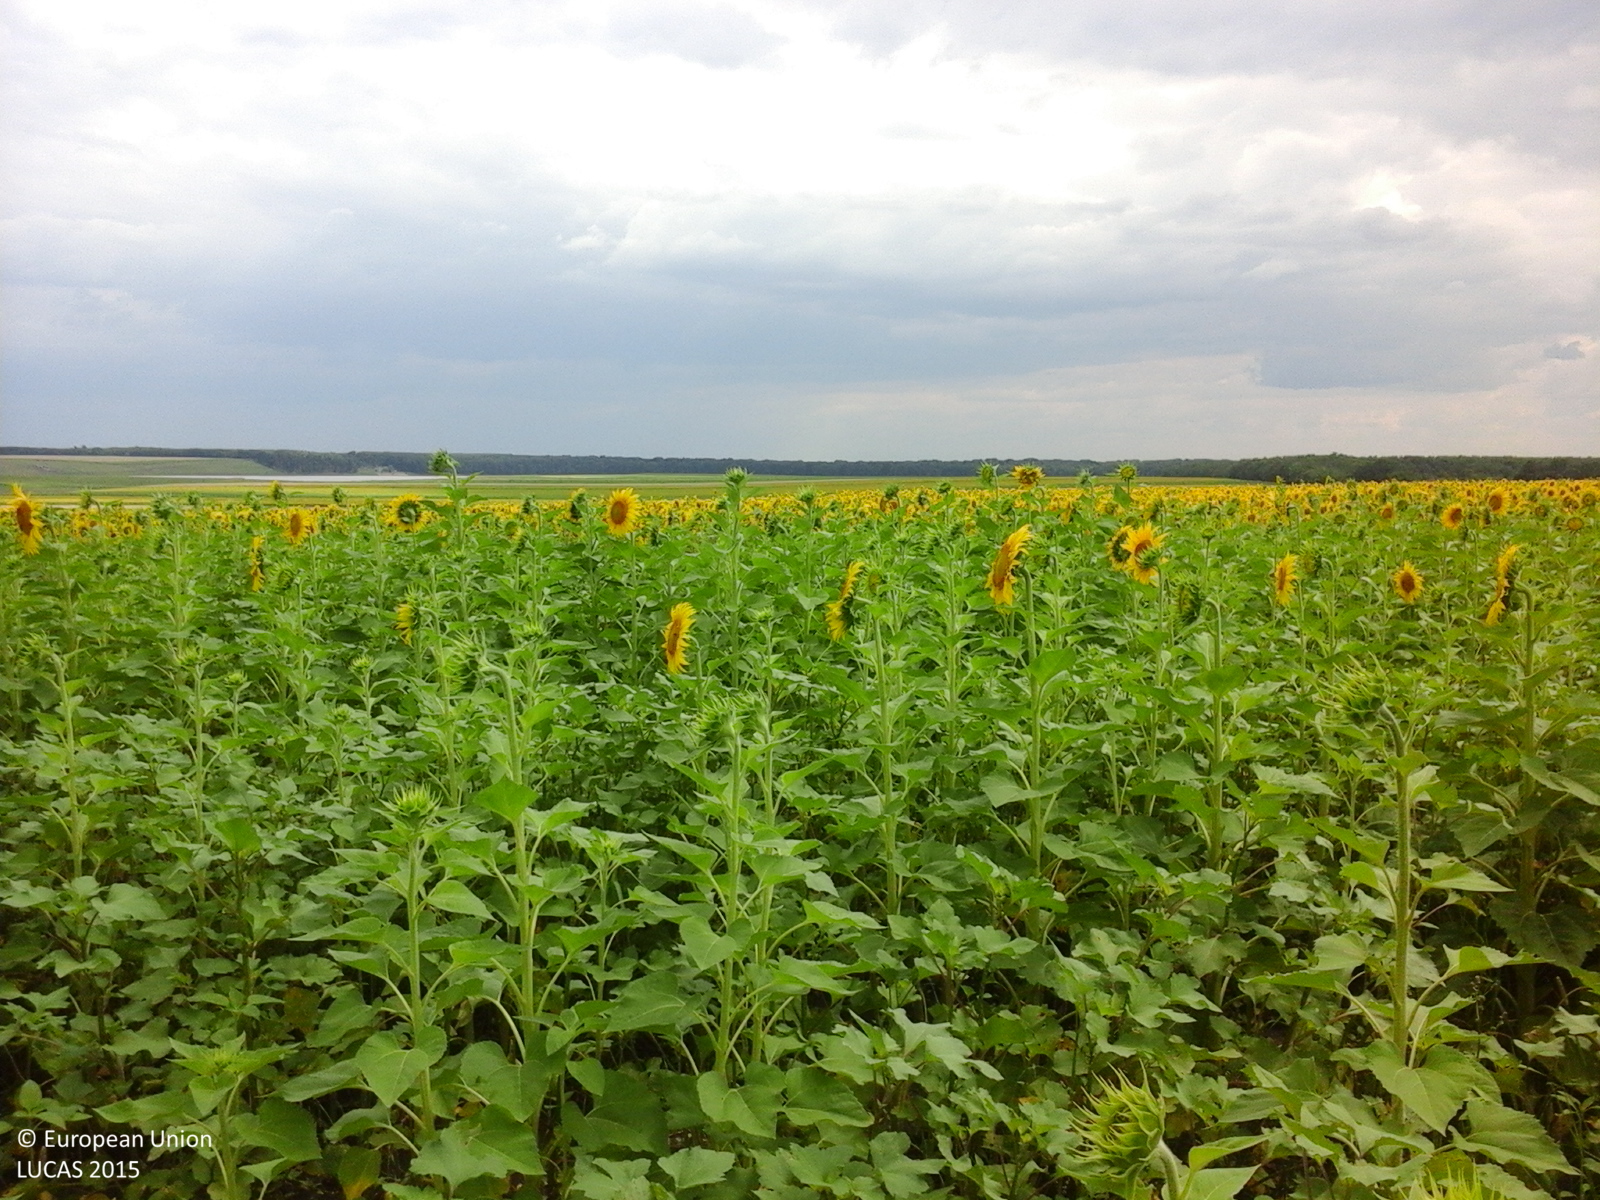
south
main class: Cropland
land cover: Sunflower
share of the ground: 25 - 50 %
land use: Agriculture (excluding fallow land and kitchen gardens)
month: July
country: RO
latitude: 44.0425
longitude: 24.7352
